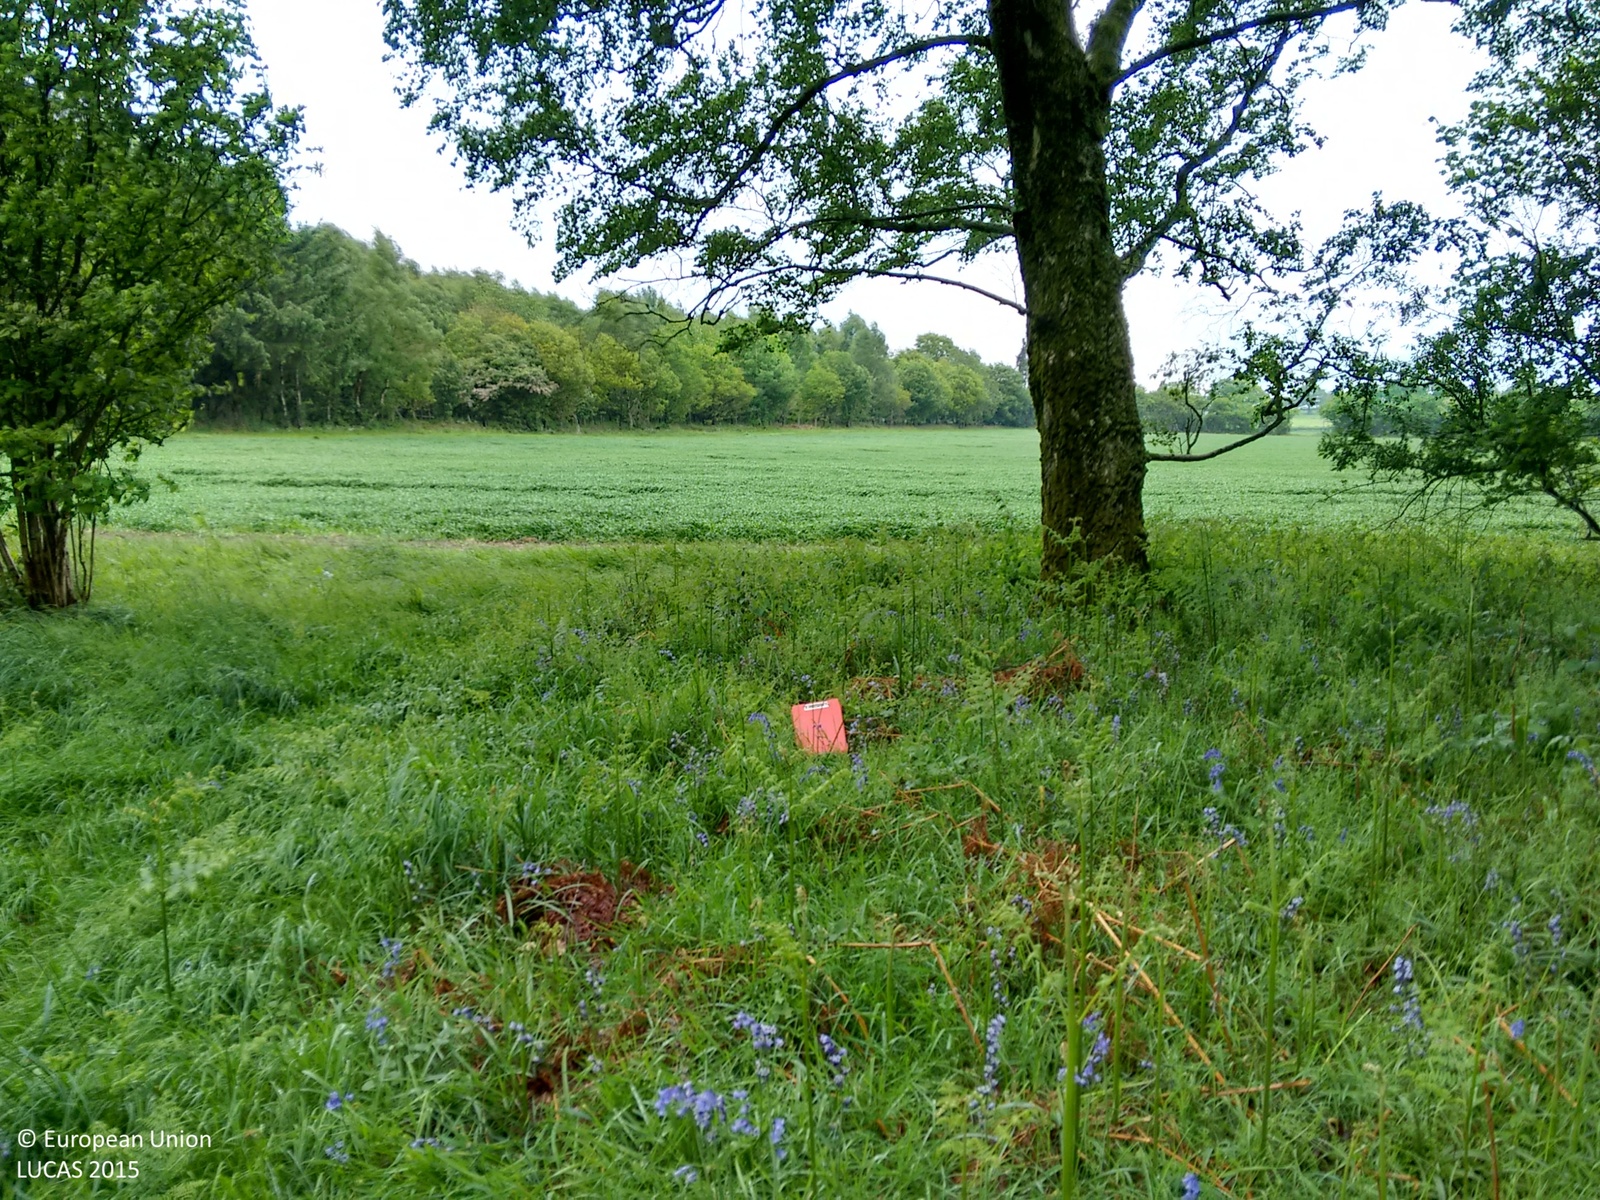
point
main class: Woodland
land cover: Broadleaved woodland
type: mesophytic deciduous forest
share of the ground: > 75 %
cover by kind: broadleaved forest trees 90 %, herbaceous plants 10 %
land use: Amenities, museums, leisure
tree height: > 5 m
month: June
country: GB
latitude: 51.1953
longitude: -1.1655
